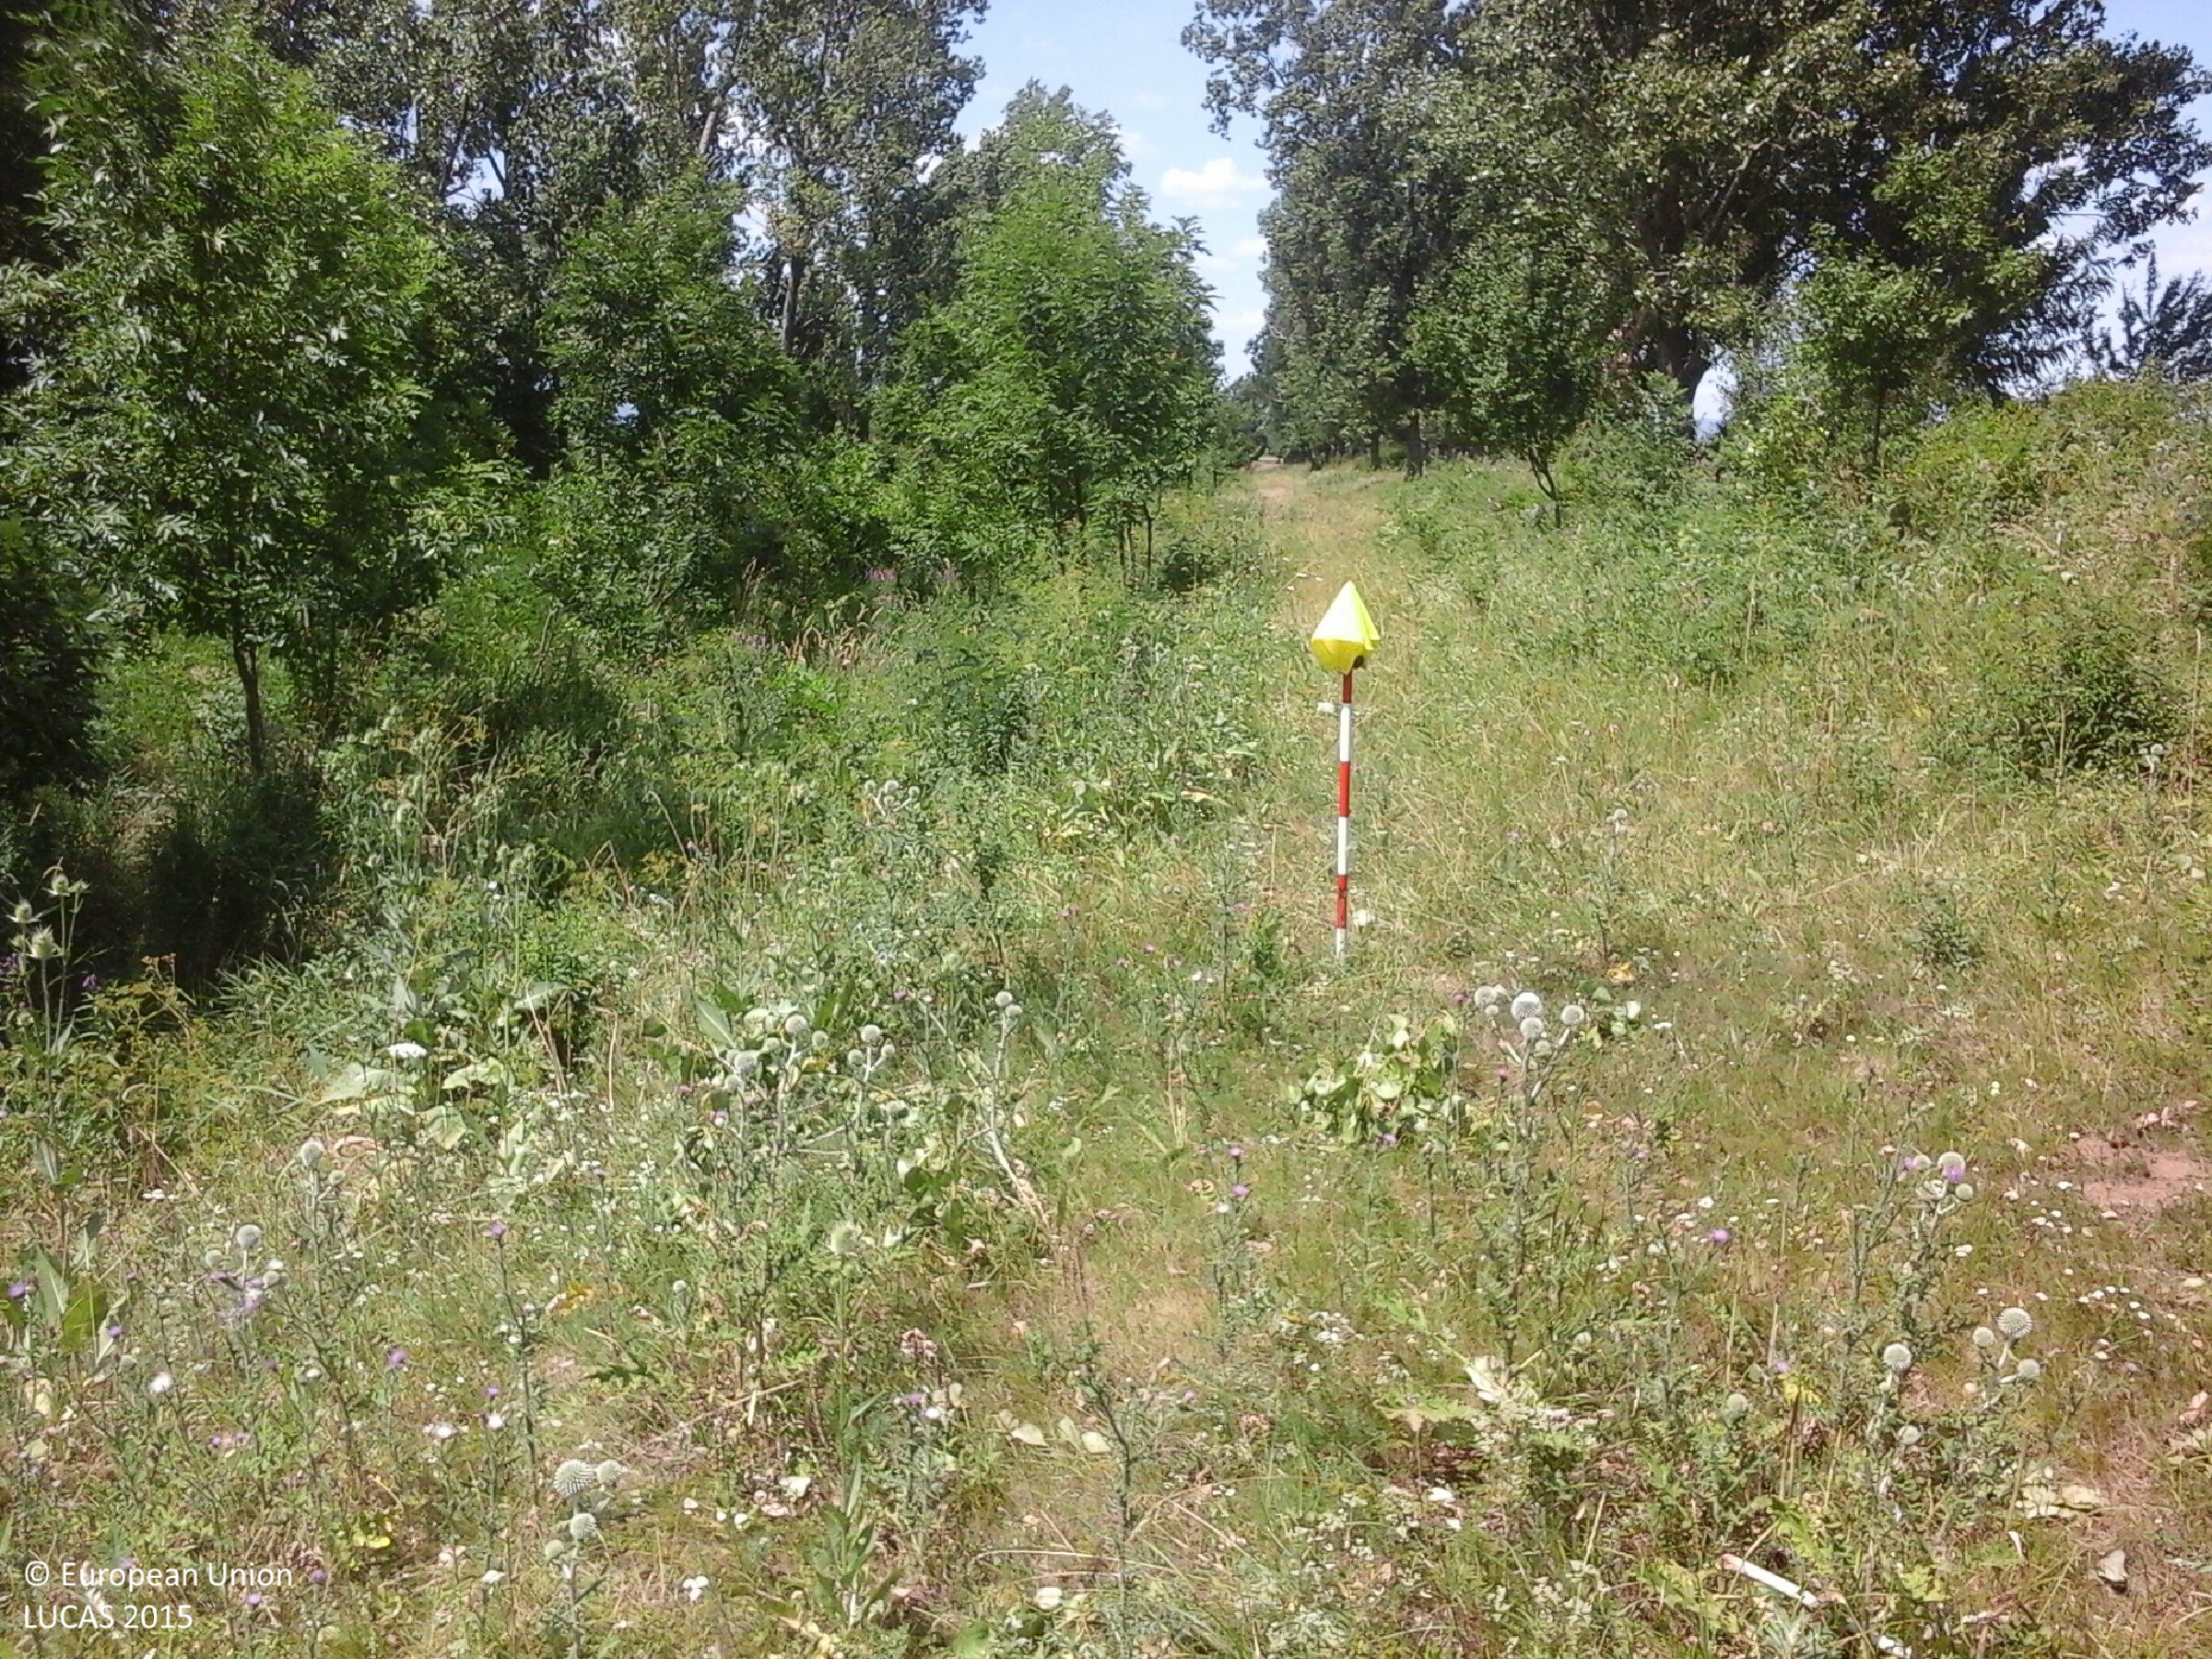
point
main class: Woodland
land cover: Broadleaved woodland
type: mesophytic deciduous forest
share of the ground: > 75 %
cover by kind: herbaceous plants 75 %, broadleaved forest trees 20 %, shrubs 5 %
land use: Semi-natural and natural areas not in use
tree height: < 5 m
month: July
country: HU
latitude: 47.8123
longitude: 20.6777
